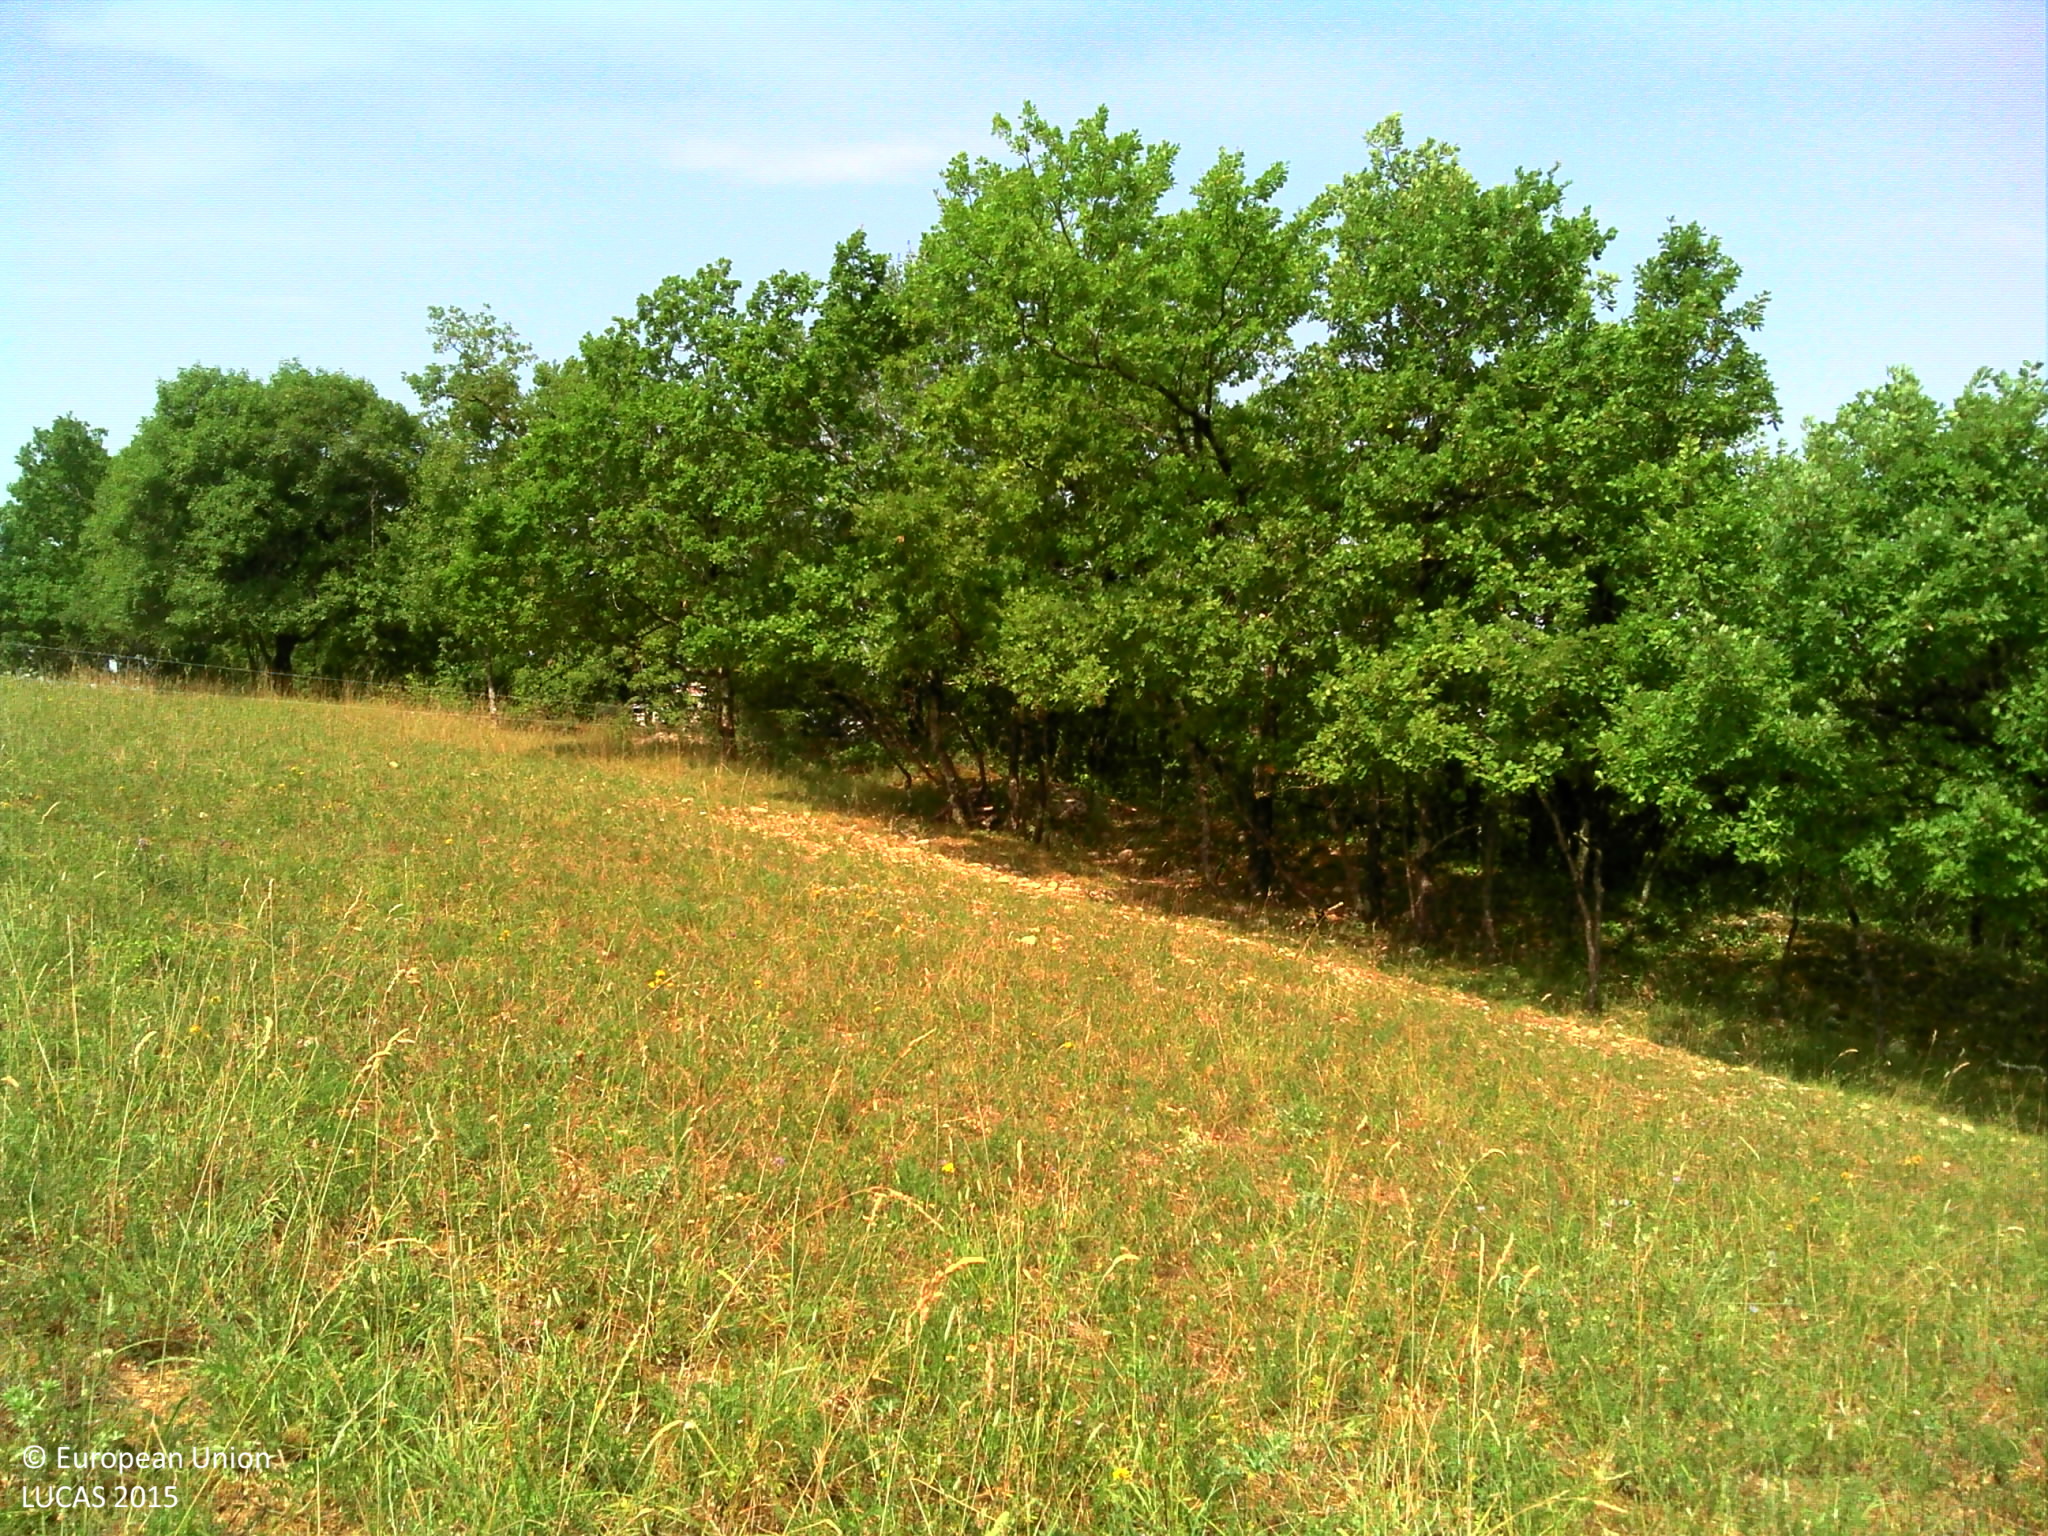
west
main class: Grassland
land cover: Grassland without tree/shrub cover
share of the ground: > 75 %
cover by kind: herbaceous plants 100 %
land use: Agriculture (excluding fallow land and kitchen gardens)
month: July
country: FR
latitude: 44.4495
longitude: 1.0110
